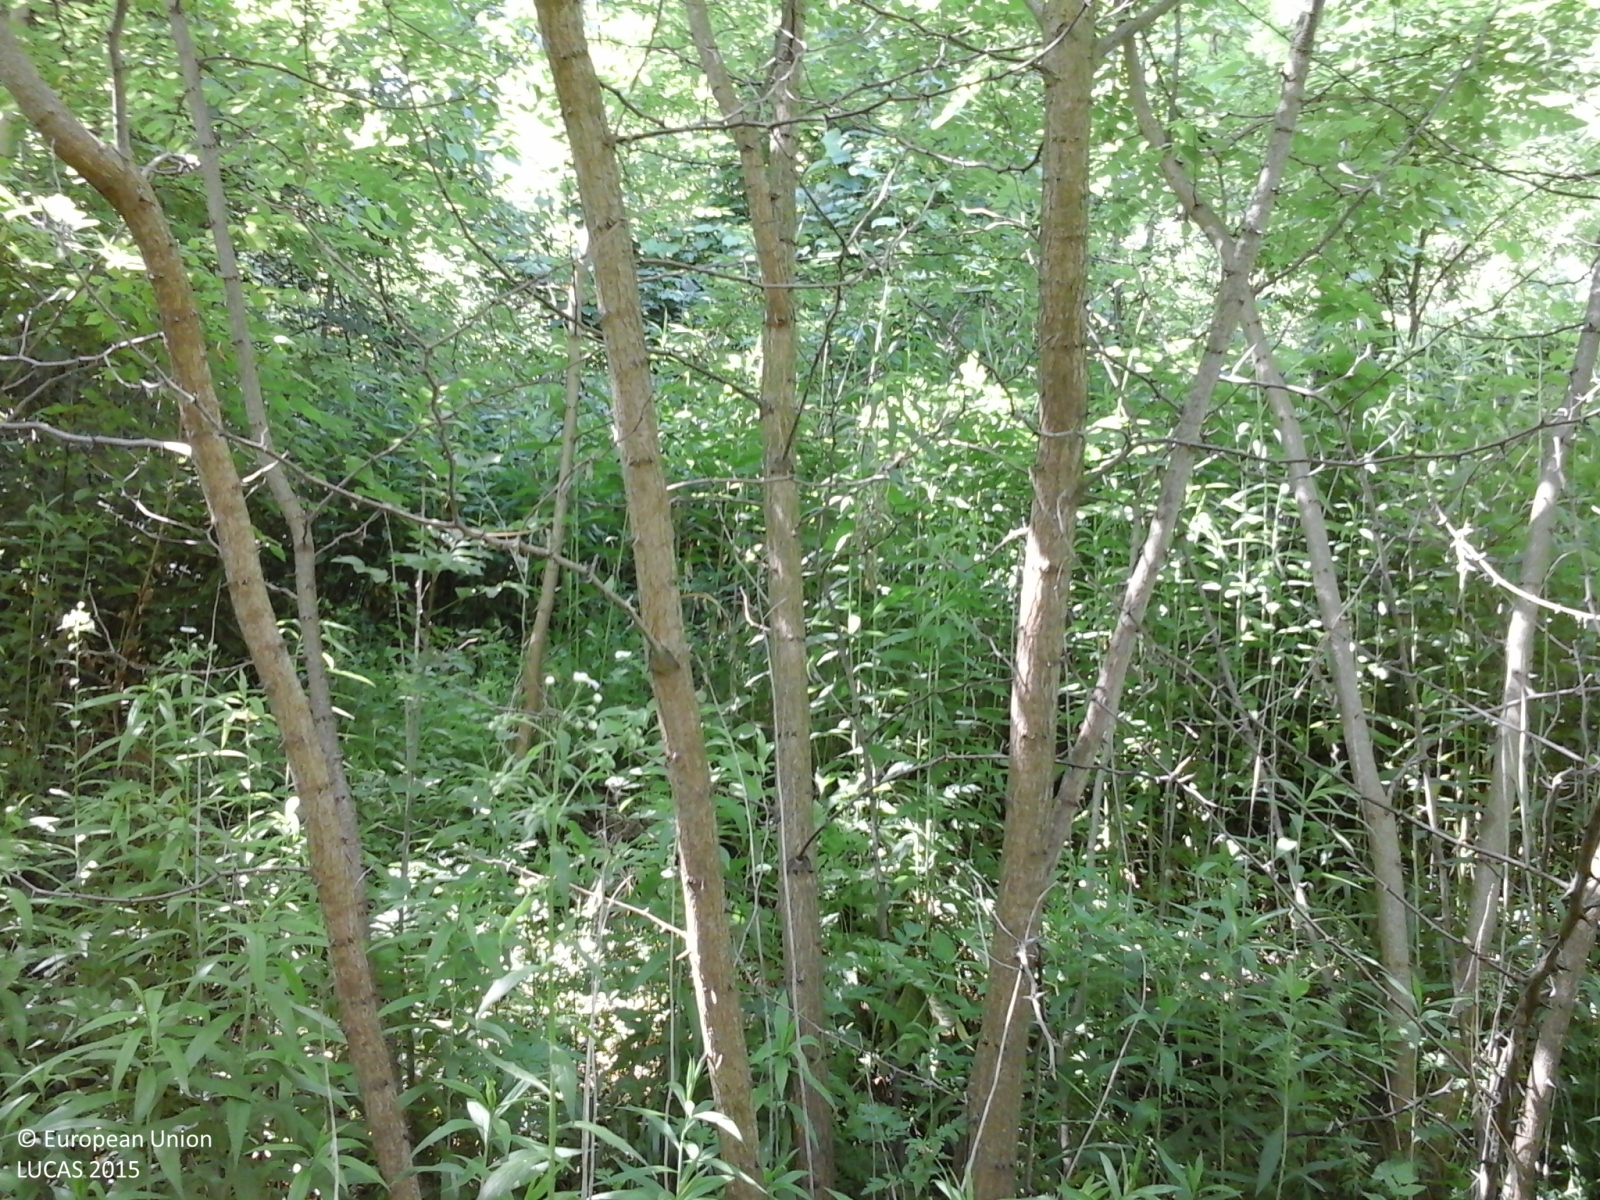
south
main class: Woodland
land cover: Broadleaved woodland
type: mesophytic deciduous forest
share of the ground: > 75 %
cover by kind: broadleaved forest trees 85 %, shrubs 10 %, herbaceous plants 5 %
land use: Forestry
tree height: > 5 m
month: June
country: IT
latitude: 44.6437
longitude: 8.3266
